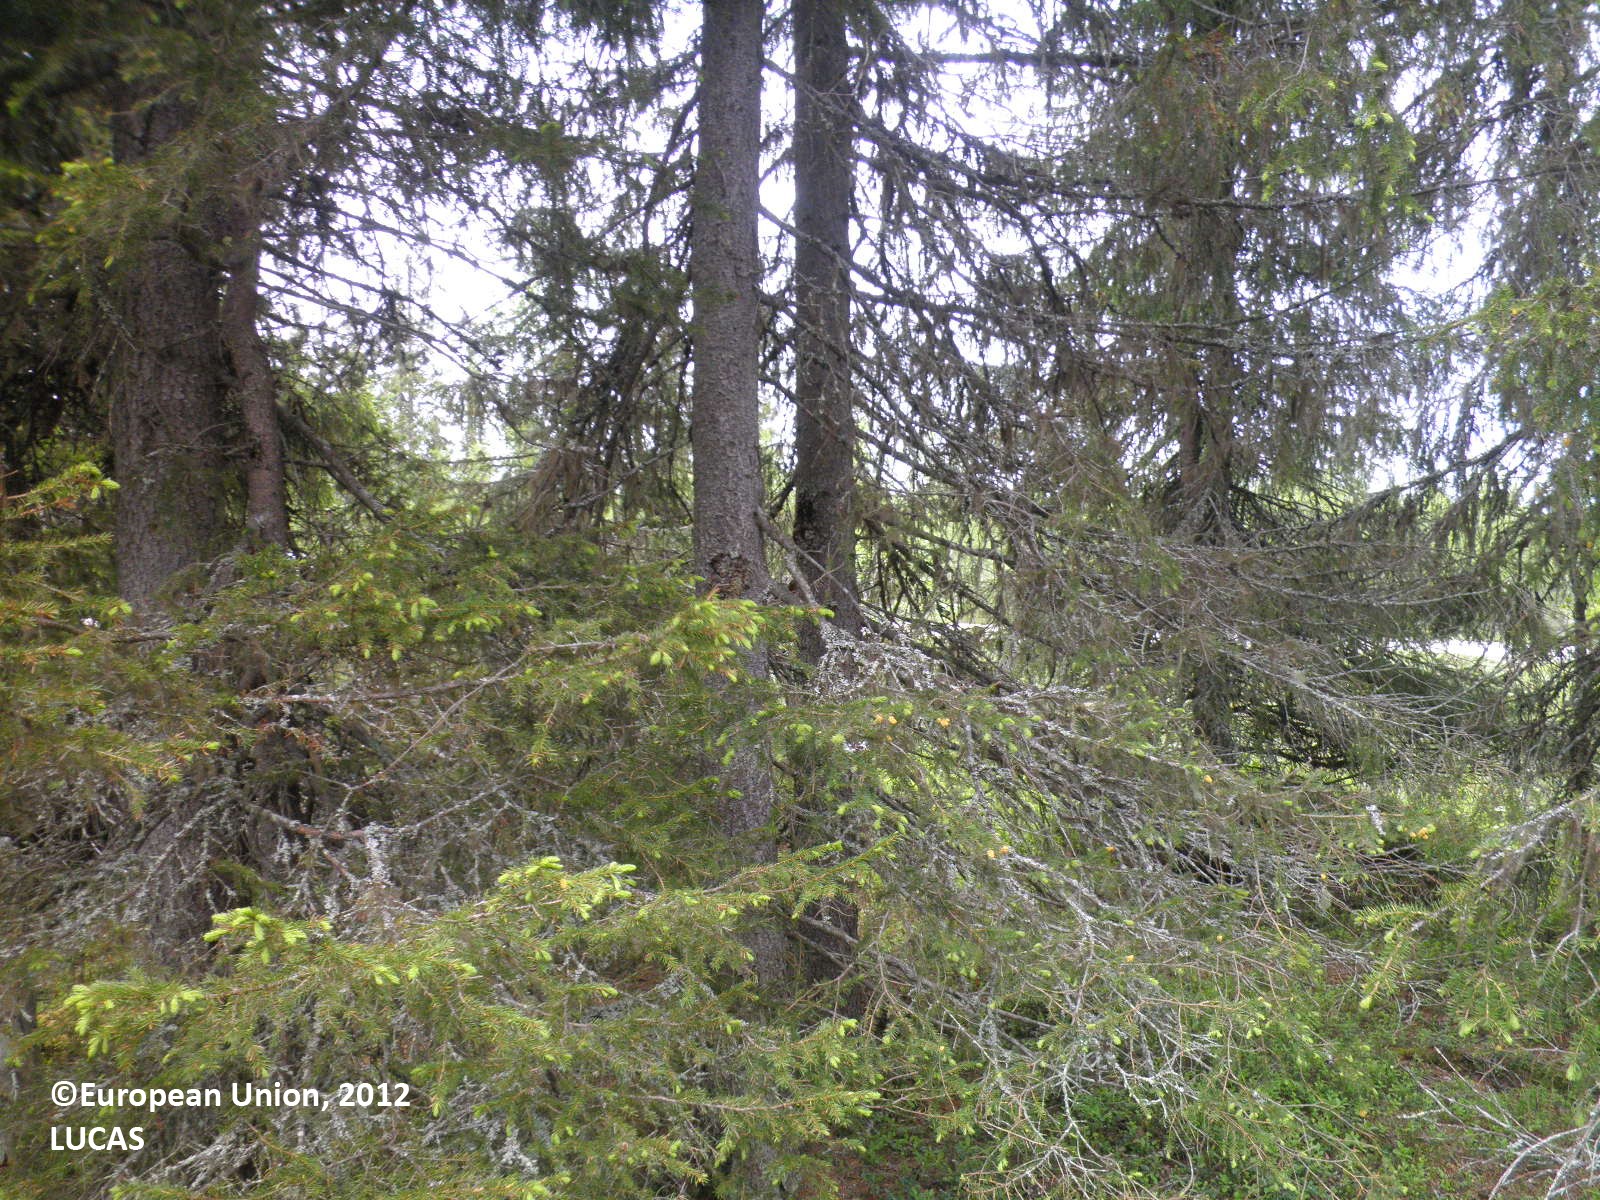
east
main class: Woodland
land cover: Spruce dominated mixed woodland
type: boreal forest
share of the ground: 50 - 75 %
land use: Forestry
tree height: > 5 m
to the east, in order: Spruce dominated mixed woodland; Rivers and streams; Spontaneously vegetated surfaces; Paved roads, cycling and walking lanes; Spontaneously vegetated surfaces; Rivers and streams; Spontaneously vegetated surfaces; Spruce dominated mixed woodland; Fences; Electric lines; Spontaneously vegetated surfaces; Broadleaved woodland; Pine dominated mixed woodland
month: July
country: FI
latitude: 68.5250
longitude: 26.1266
